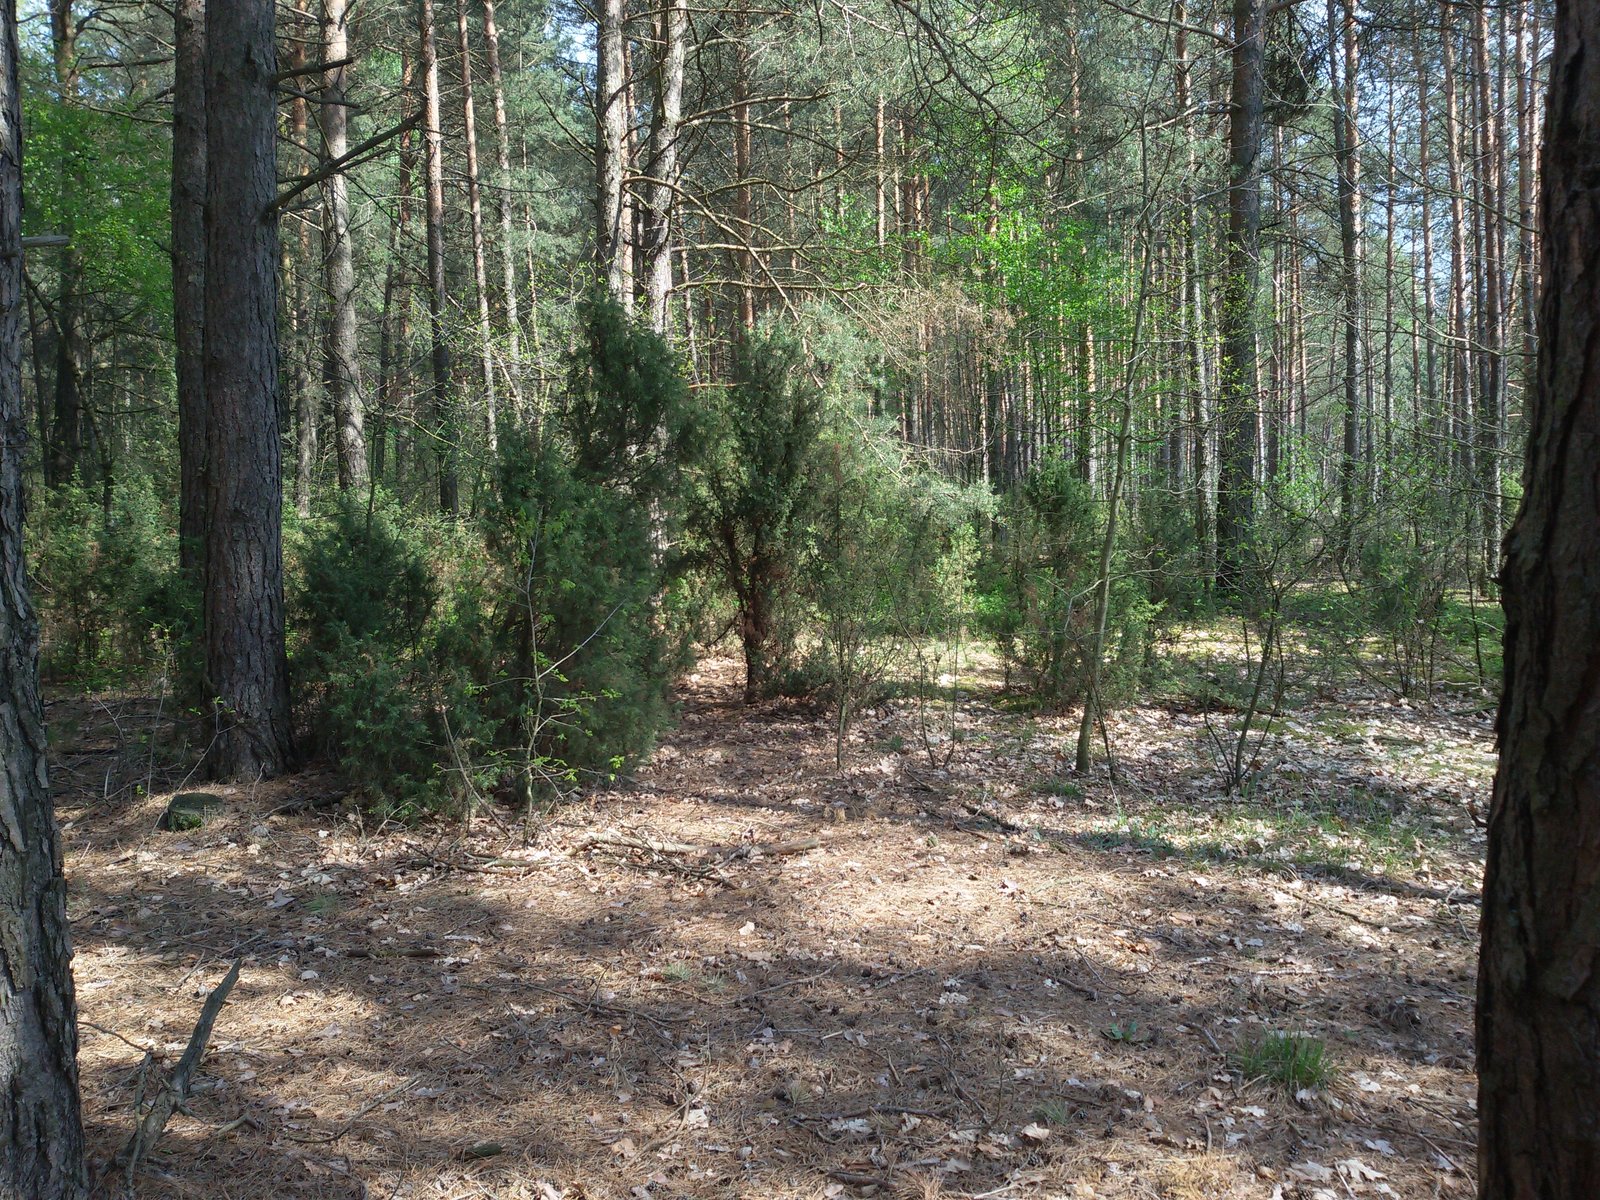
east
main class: Woodland
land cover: Pine dominated coniferous woodland
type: hemiboreal forest and nemoral coniferous forest and mixed broadleaved-coniferous forest
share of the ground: > 75 %
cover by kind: coniferous forest trees 75 %, lichens and mosses 15 %, shrubs 5 %, herbaceous plants 5 %
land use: Forestry
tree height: > 5 m
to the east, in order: Pine dominated coniferous woodland; Tracks; Pine dominated coniferous woodland
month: May
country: PL
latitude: 53.0525
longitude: 22.4021
